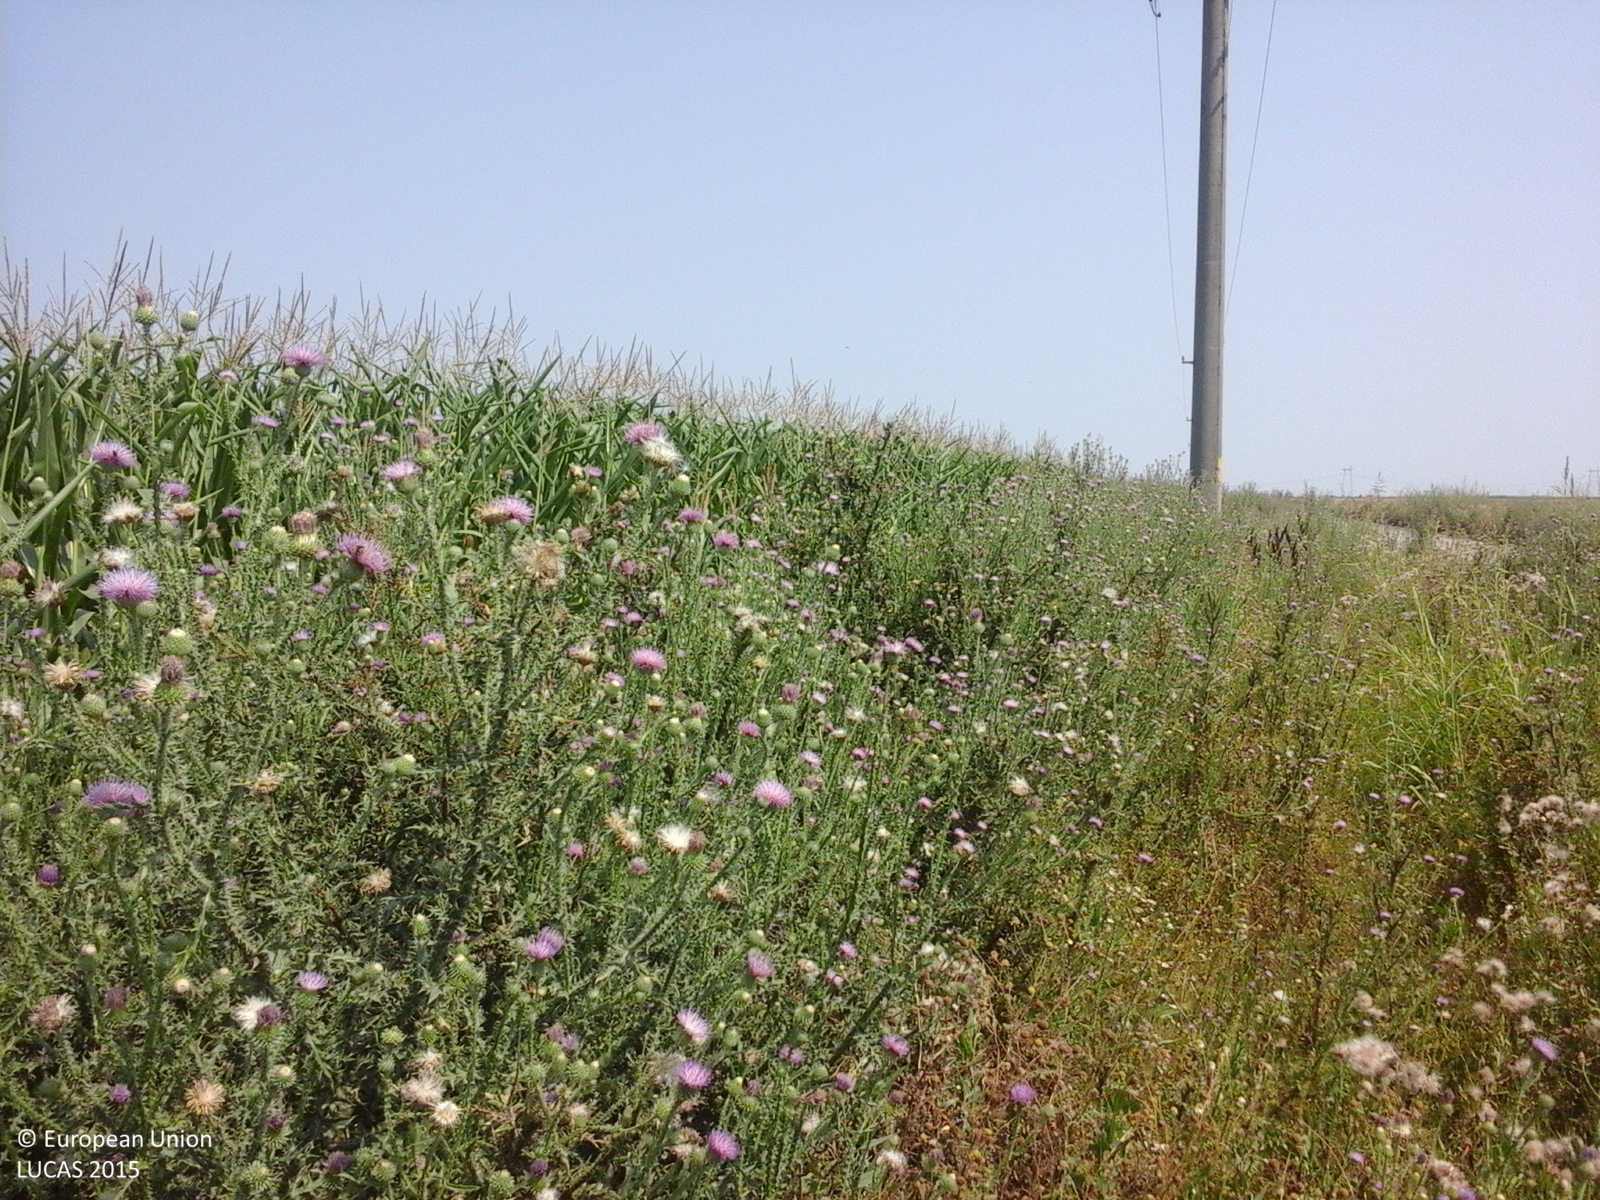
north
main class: Cropland
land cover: Maize
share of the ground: > 75 %
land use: Agriculture (excluding fallow land and kitchen gardens)
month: July
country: RO
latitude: 44.5351
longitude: 26.6691
